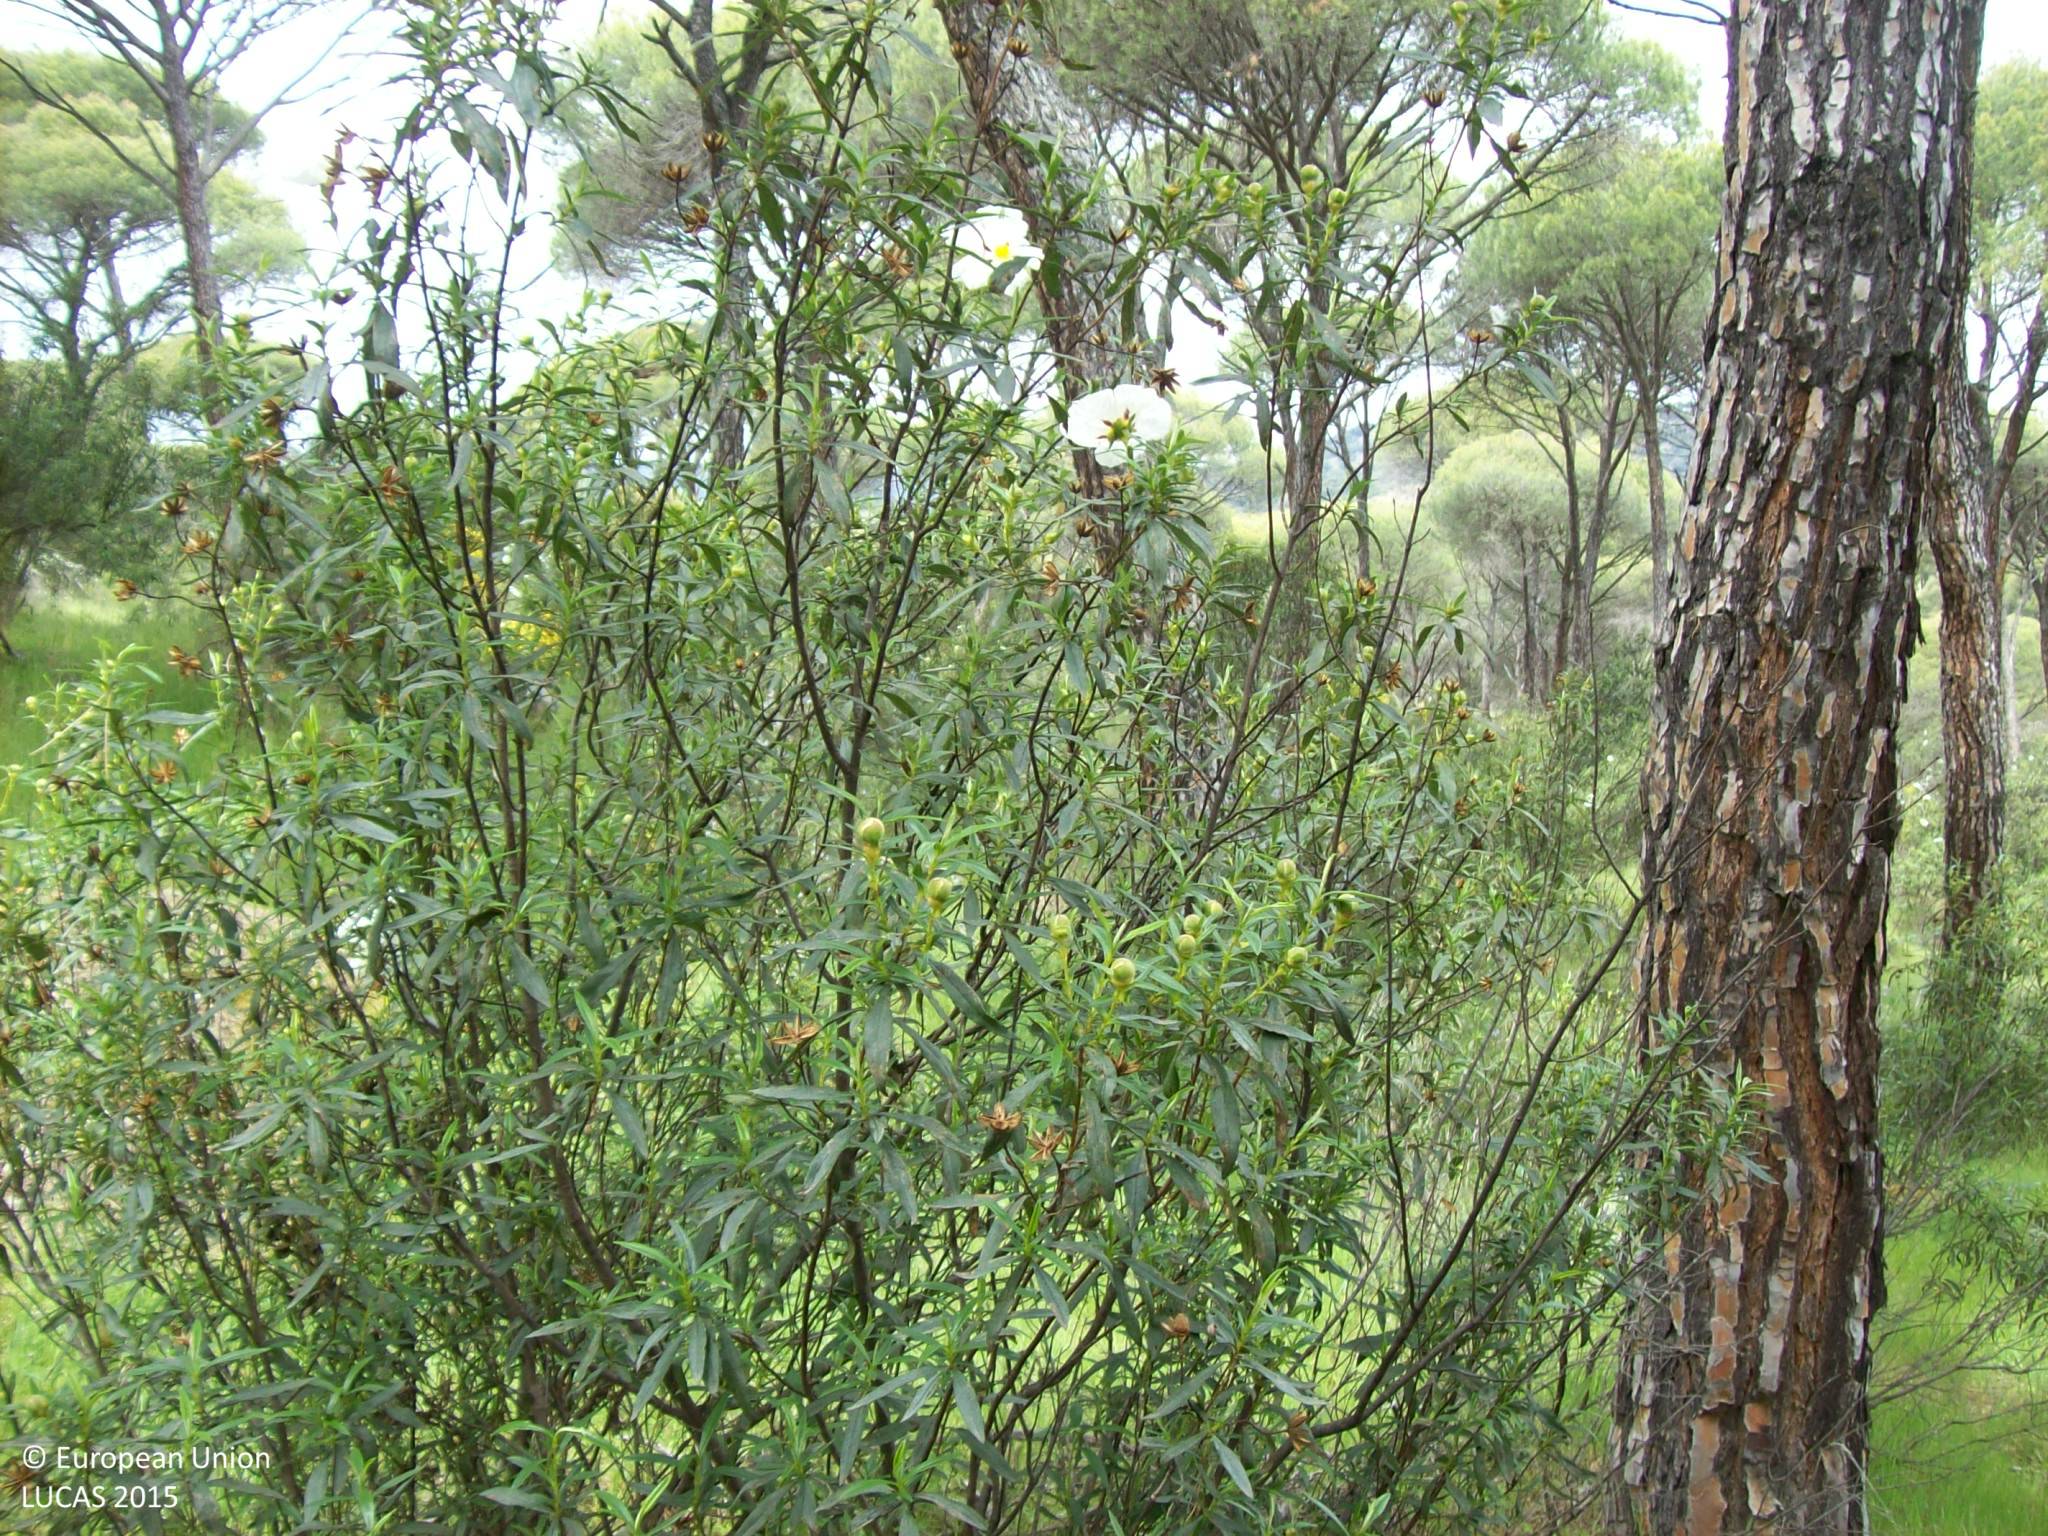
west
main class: Woodland
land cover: Pine dominated coniferous woodland
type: coniferous forest of the mediterranean region
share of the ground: > 75 %
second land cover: Grassland without tree/shrub cover
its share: > 75 %
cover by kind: coniferous forest trees 70 %, herbaceous plants 20 %, shrubs 5 %, consolidated bare surface 5 %
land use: Forestry
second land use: Agriculture (excluding fallow land and kitchen gardens)
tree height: > 5 m
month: April
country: ES
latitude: 40.4643
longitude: -4.4009
